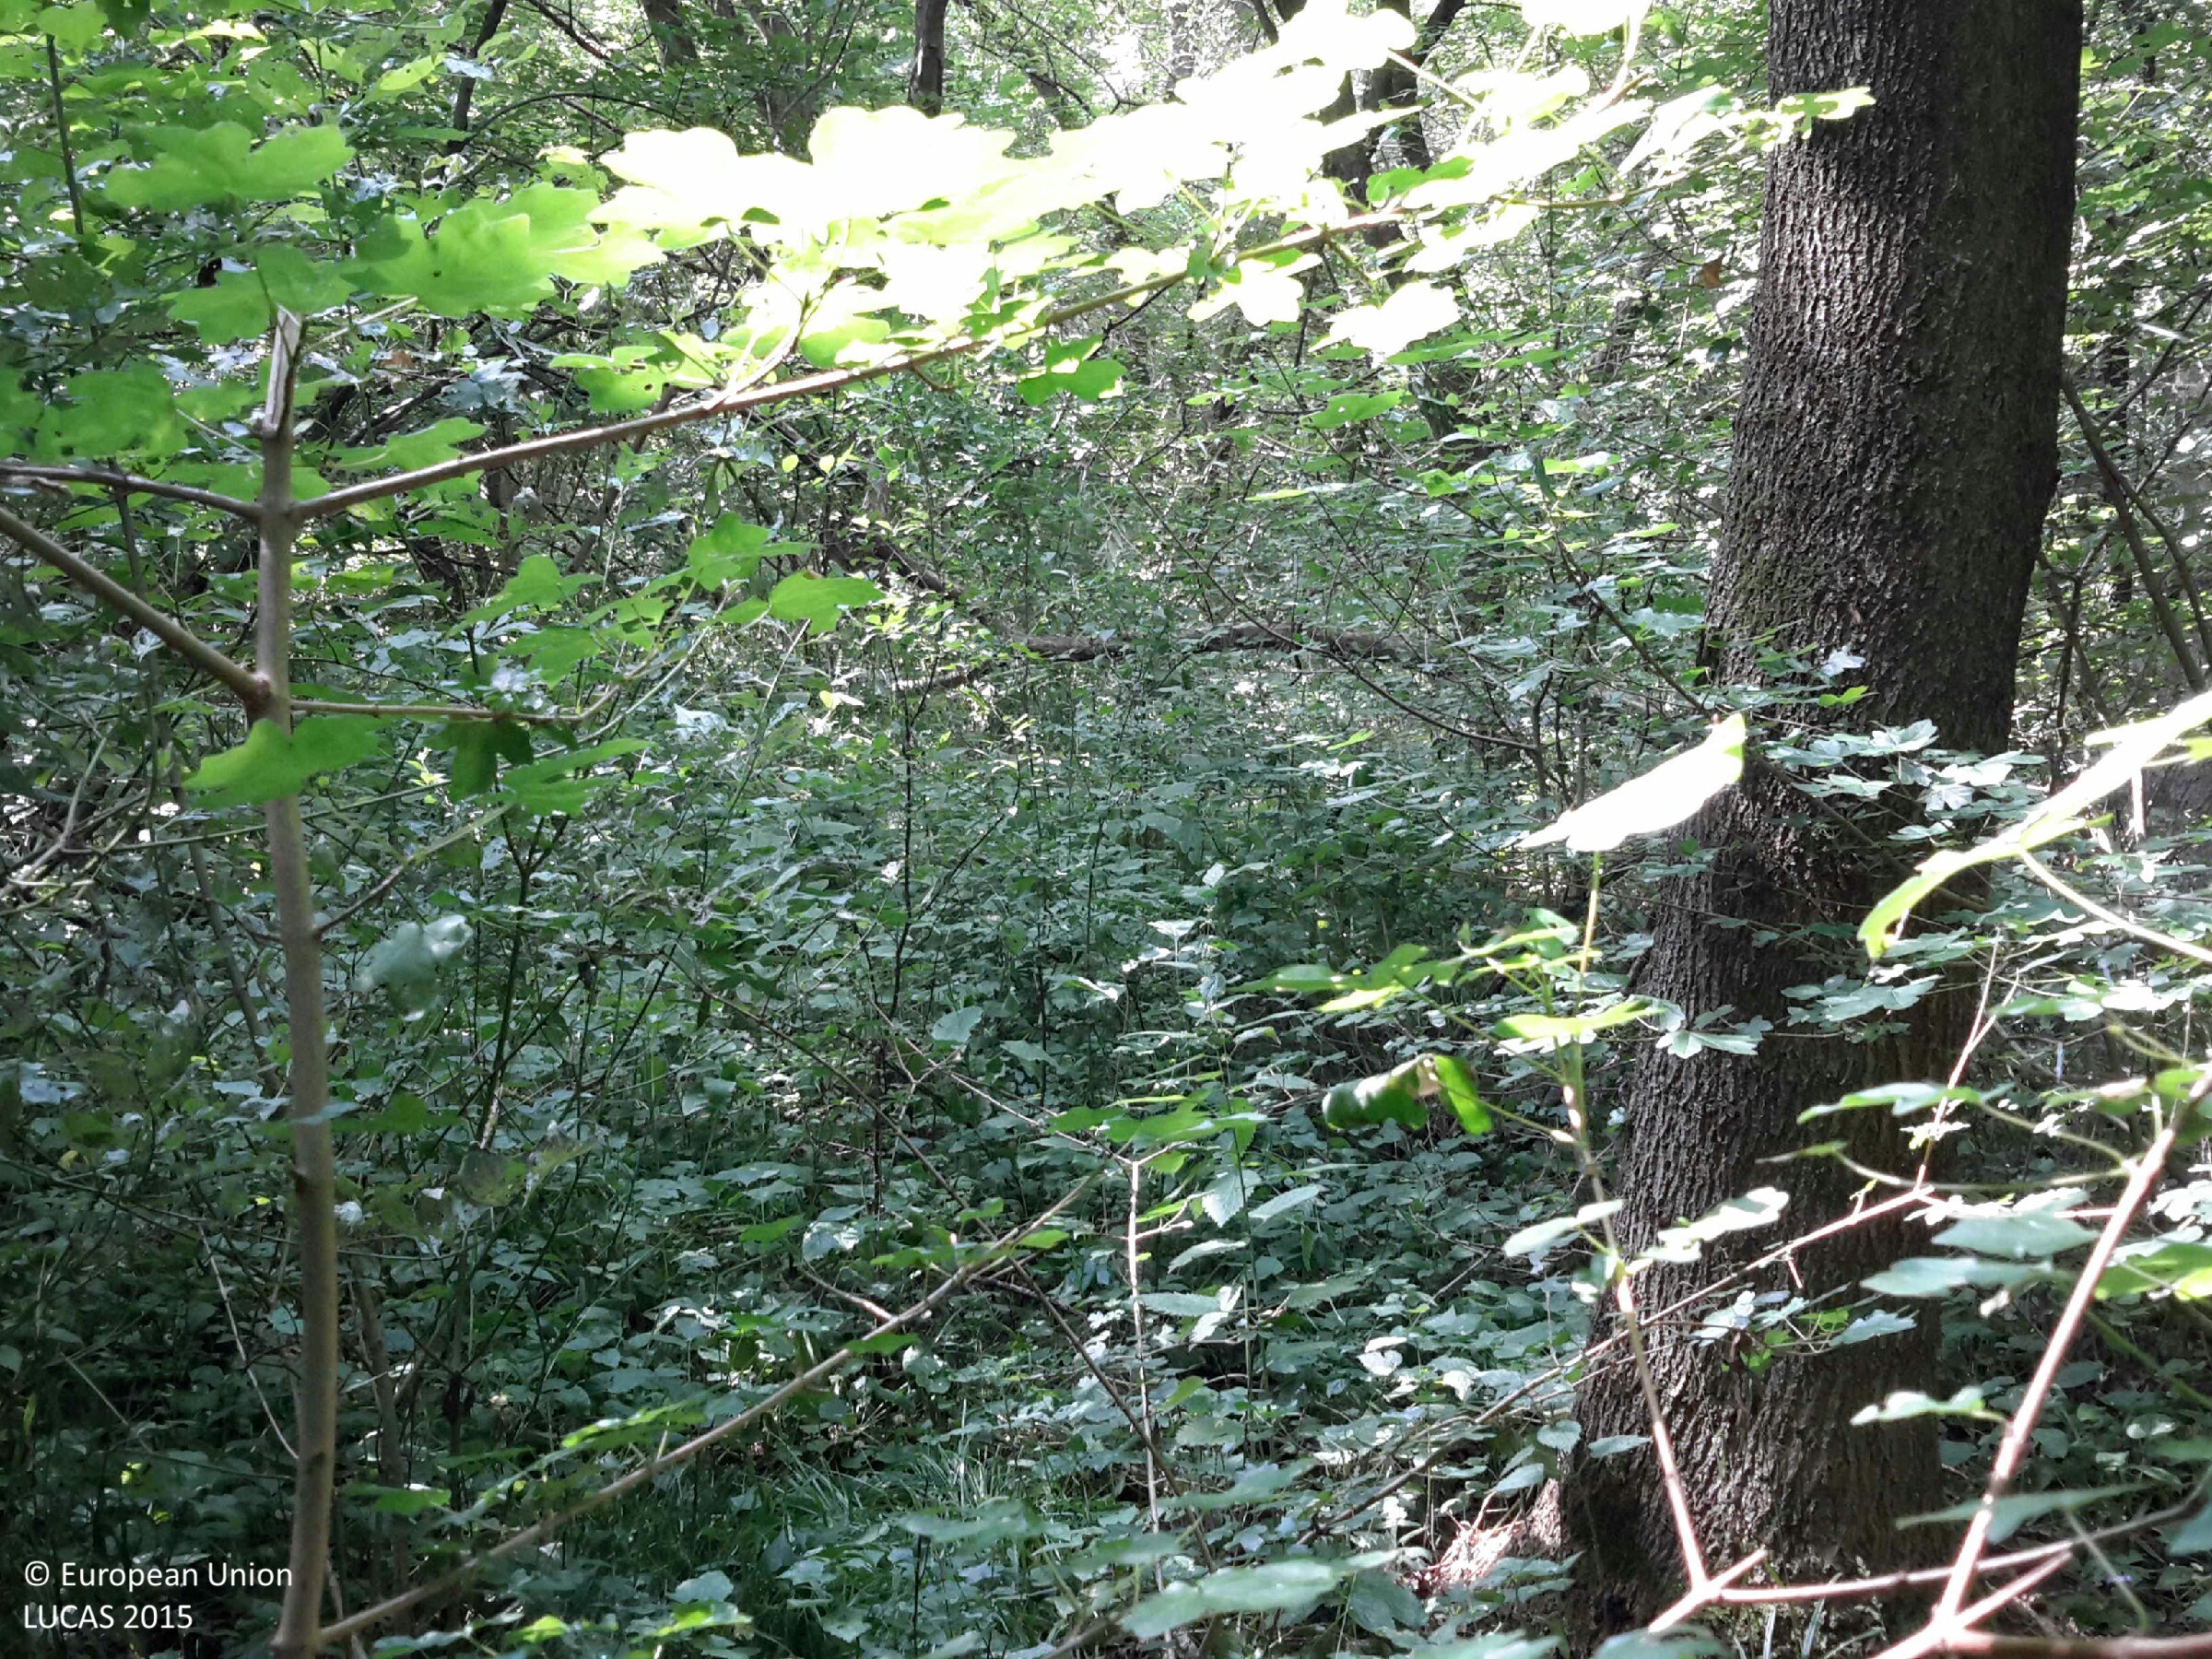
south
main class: Woodland
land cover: Broadleaved woodland
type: mesophytic deciduous forest
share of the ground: > 75 %
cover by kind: broadleaved forest trees 90 %, shrubs 5 %, herbaceous plants 5 %
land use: Forestry
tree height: > 5 m
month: July
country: HU
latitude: 47.4397
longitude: 17.0202
